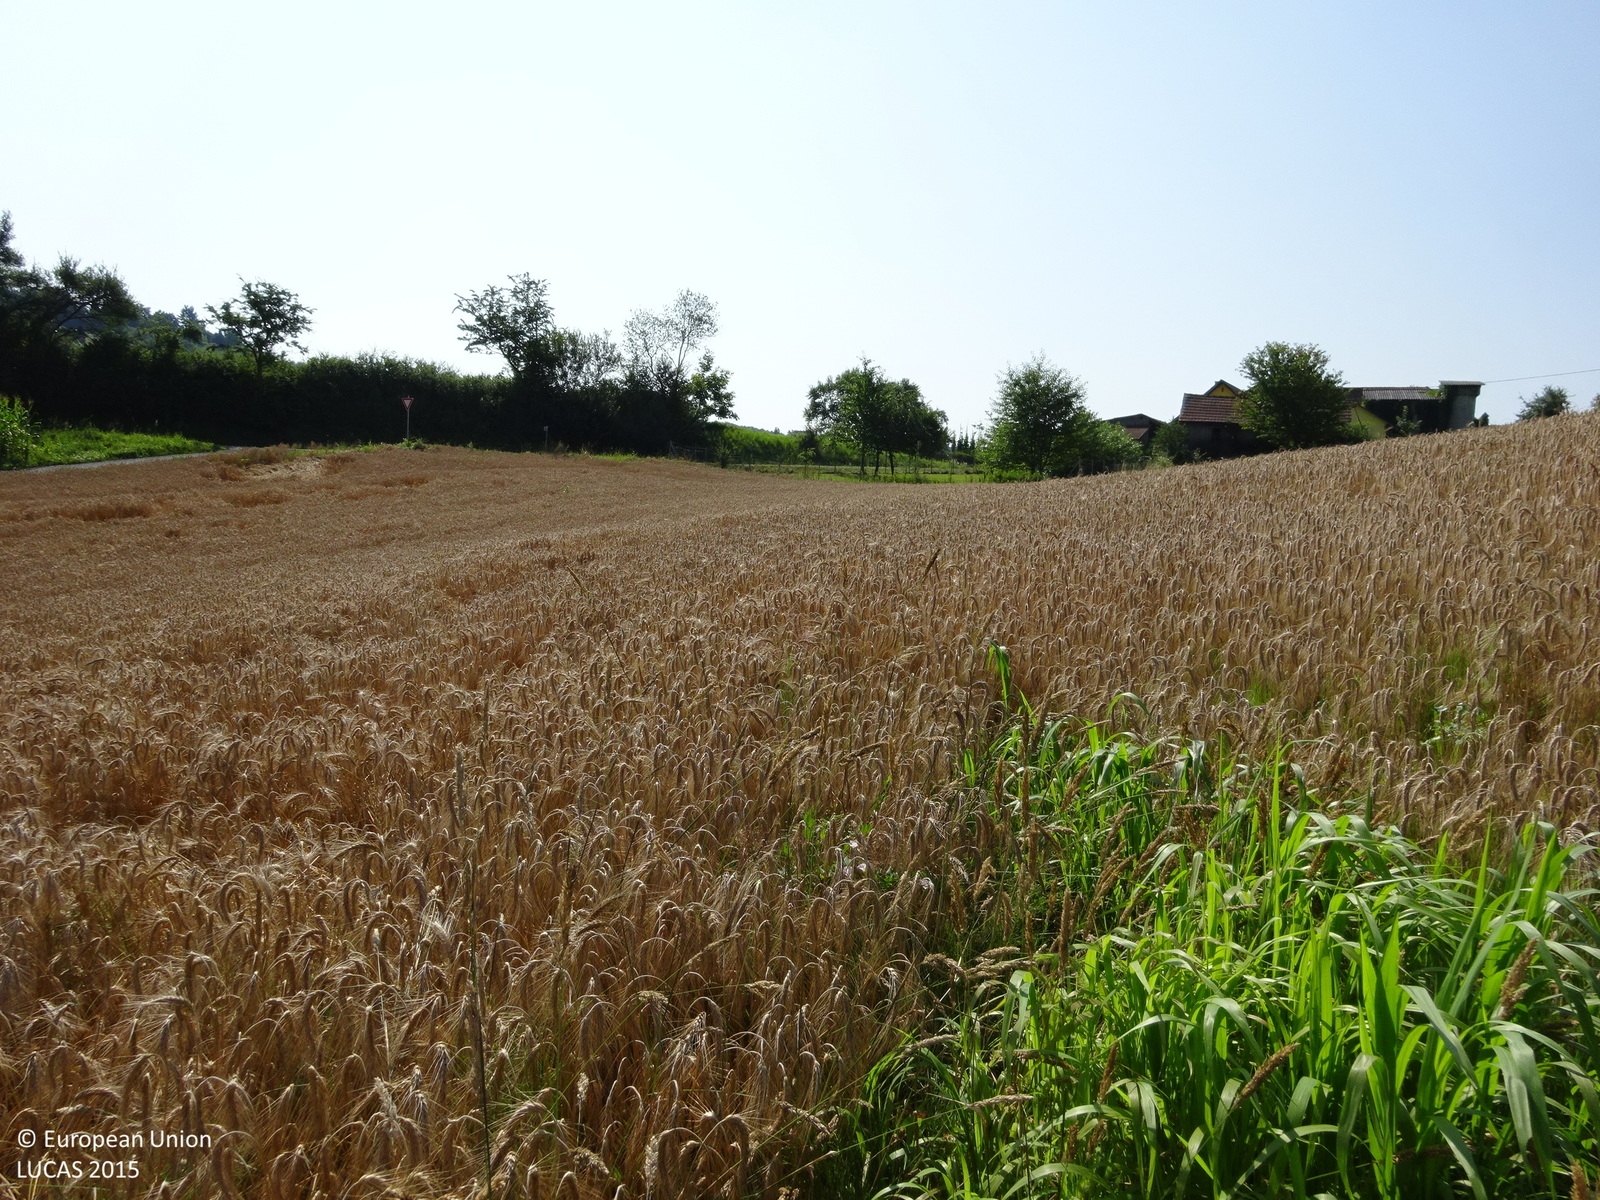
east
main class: Cropland
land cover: Barley
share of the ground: > 75 %
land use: Agriculture (excluding fallow land and kitchen gardens)
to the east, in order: Barley; Grass margins; Paved roads, cycling and walking lanes; Grass margins; Maize; Grass margins; Paved roads, cycling and walking lanes; Ditches and canals; Managed hedges; Grassland without tree/shrub cover; Soya
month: July
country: AT
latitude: 46.8252
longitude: 15.4656
